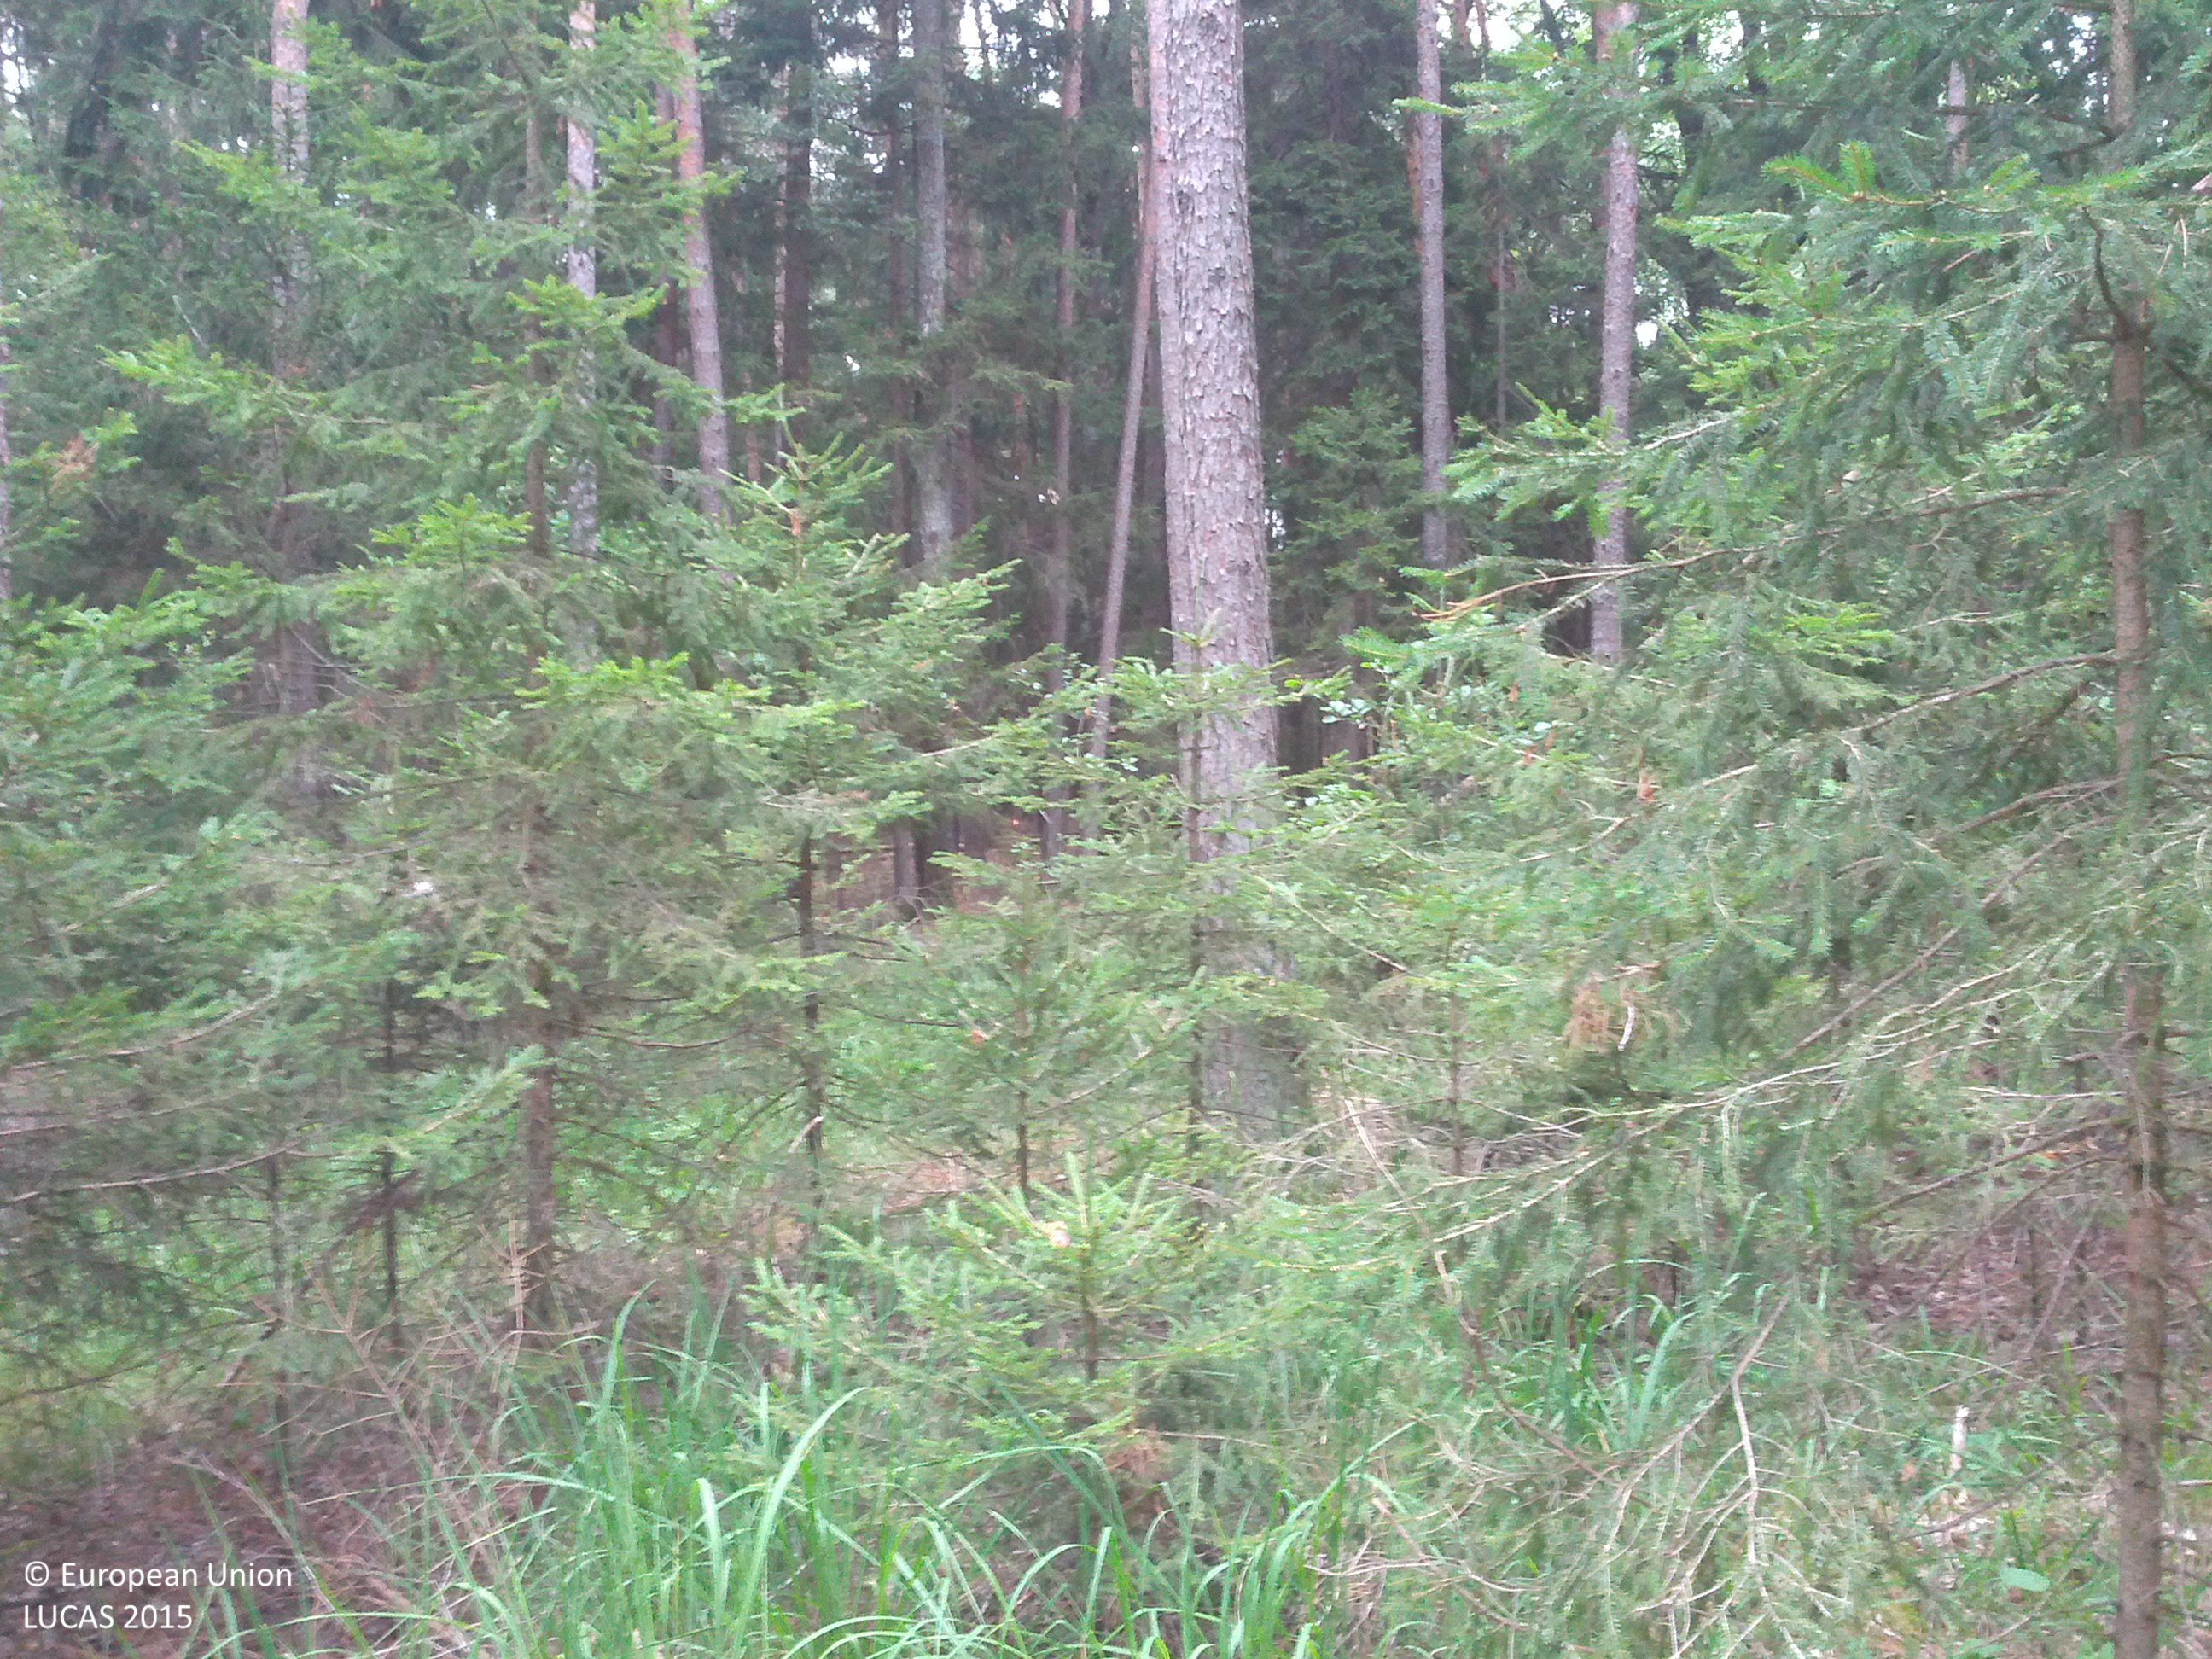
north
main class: Woodland
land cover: Pine dominated coniferous woodland
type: hemiboreal forest and nemoral coniferous forest and mixed broadleaved-coniferous forest
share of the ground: > 75 %
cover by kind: coniferous forest trees 80 %, herbaceous plants 15 %, unconsolidated bare surface 5 %
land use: Forestry
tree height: > 5 m
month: July
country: AT
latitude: 47.3475
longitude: 16.1575
